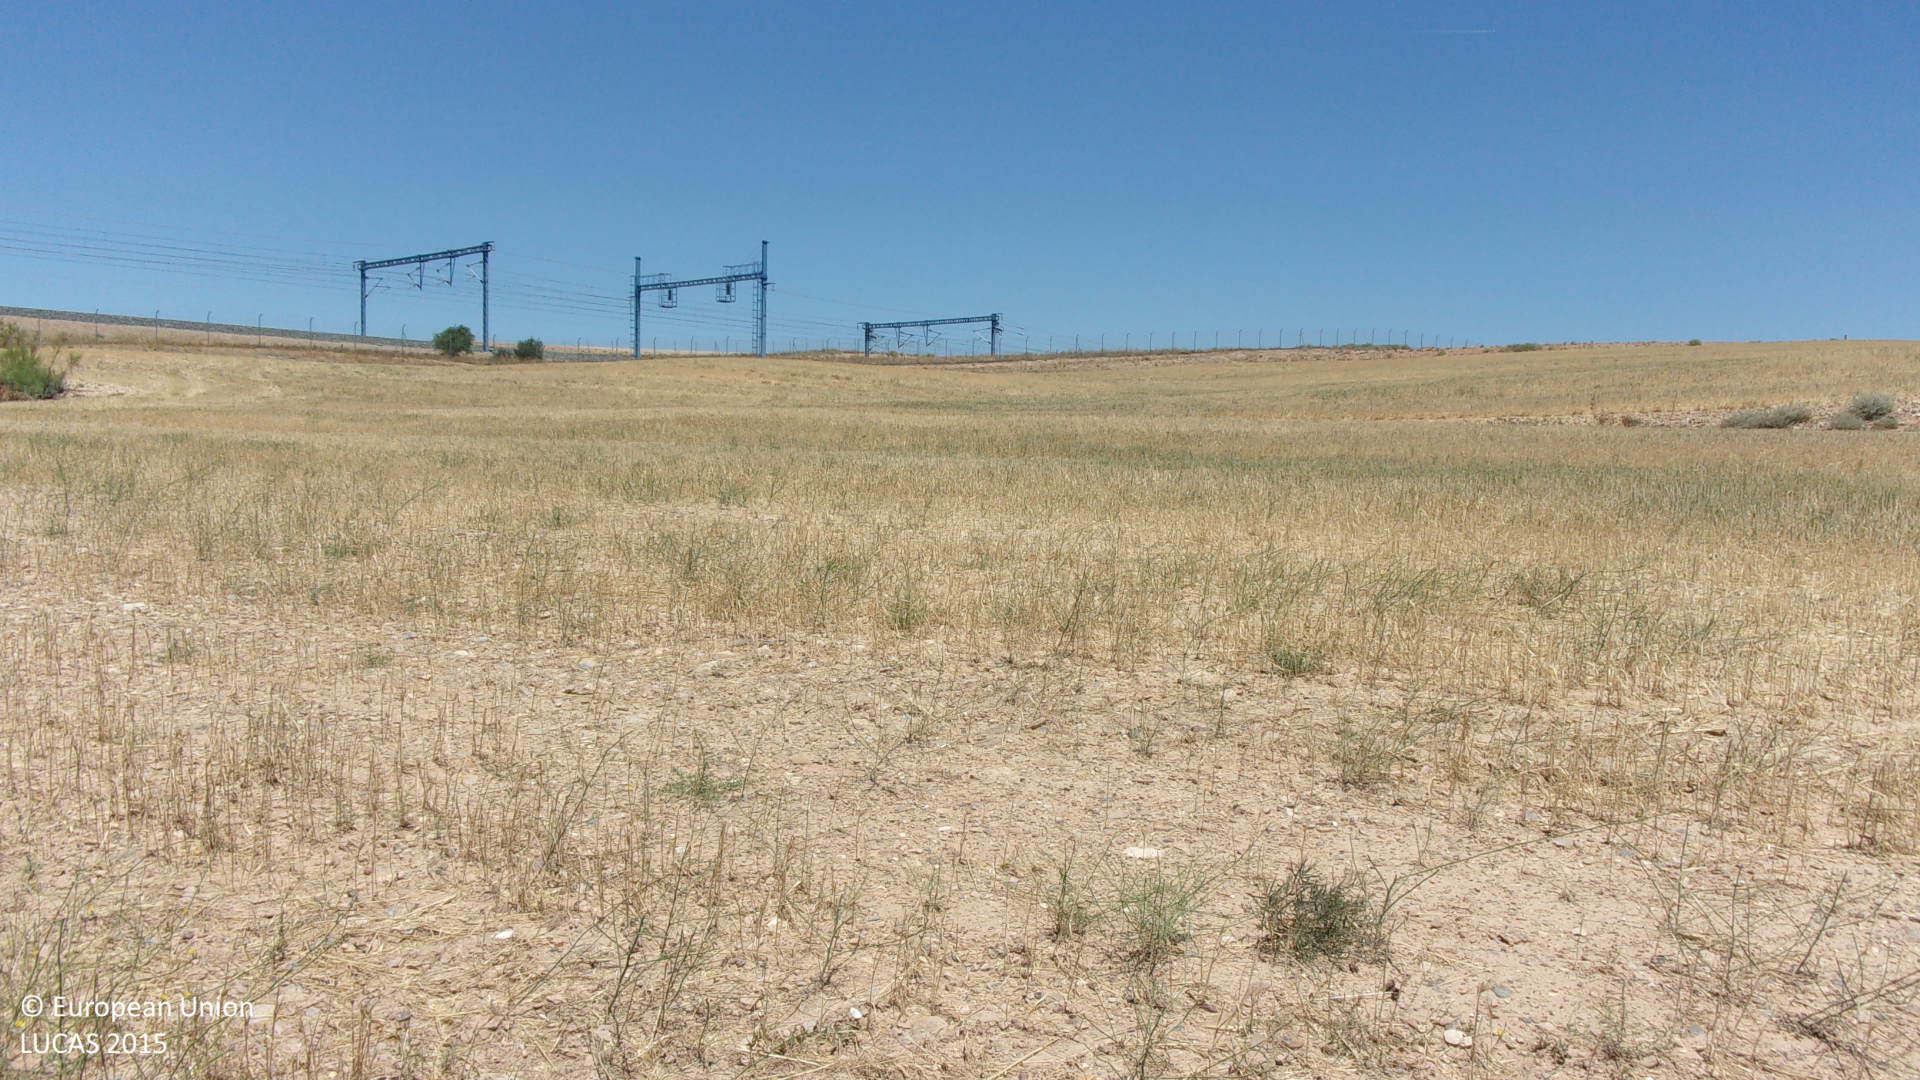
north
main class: Cropland
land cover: Durum wheat
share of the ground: < 10 %
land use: Agriculture (excluding fallow land and kitchen gardens)
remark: Harvested field
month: July
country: ES
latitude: 41.6783
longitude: -1.2567
